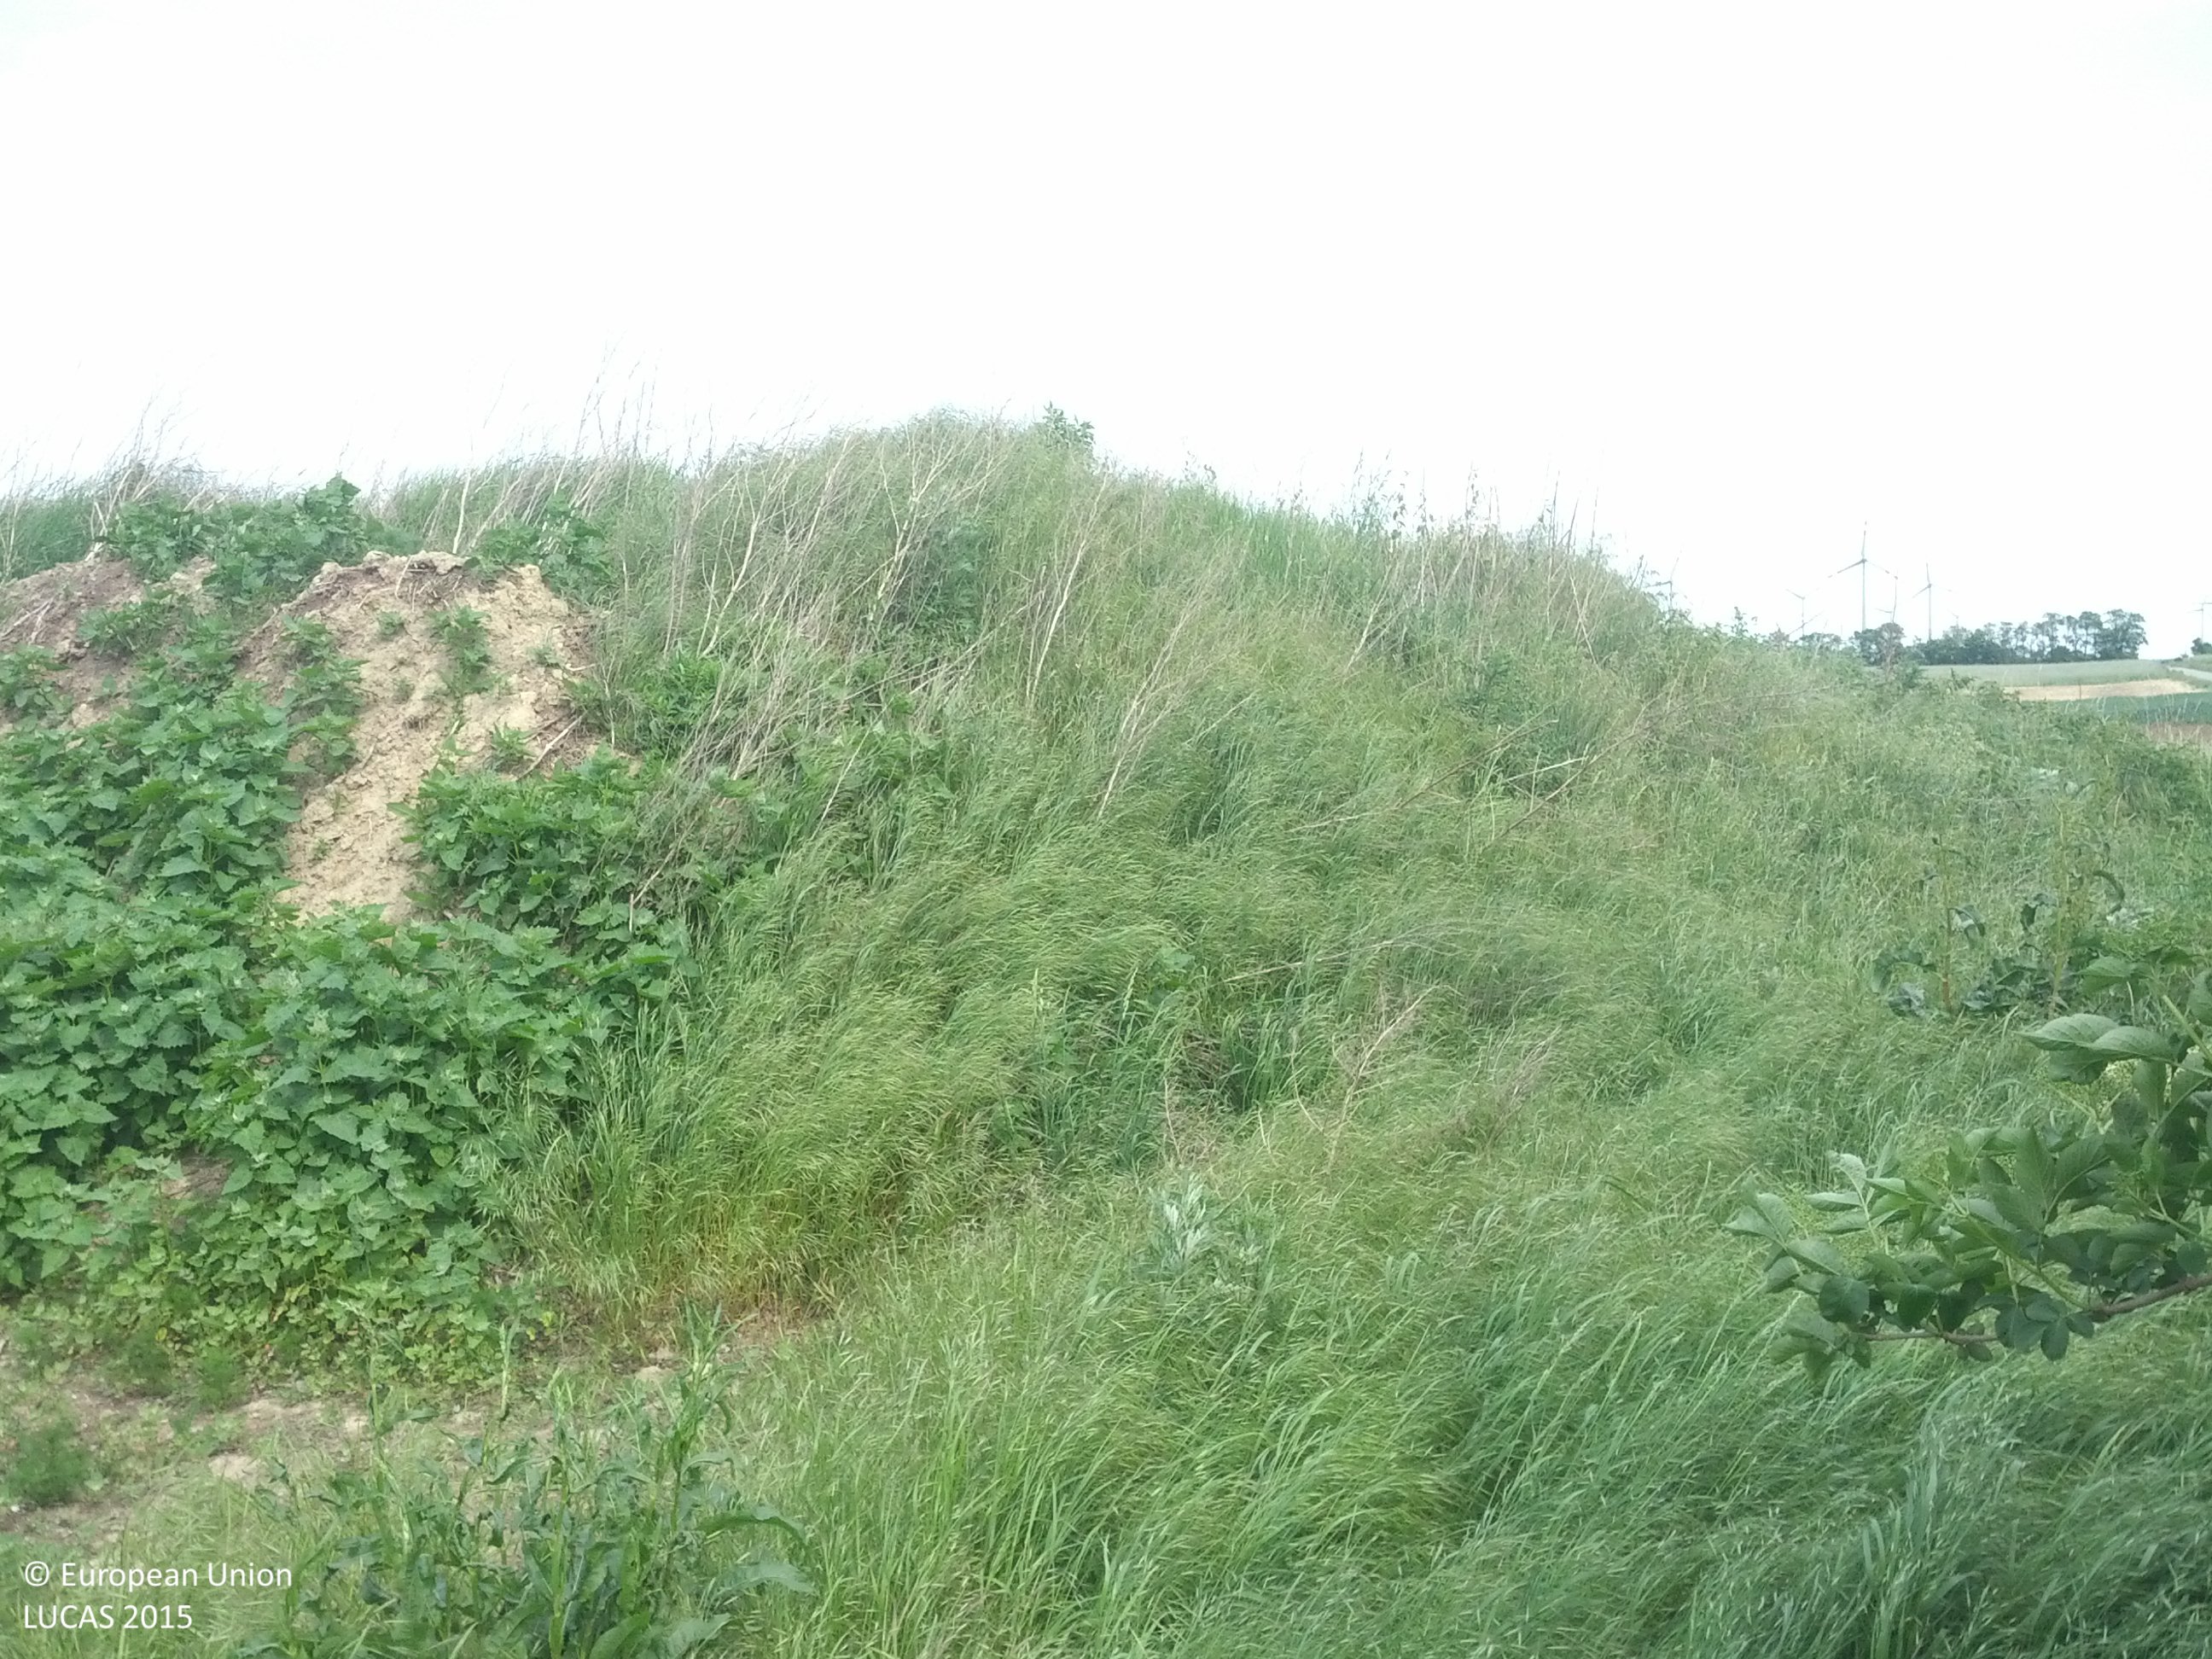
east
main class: Grassland
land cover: Spontaneously vegetated surfaces
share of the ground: > 75 %
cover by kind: herbaceous plants 65 %, unconsolidated bare surface 30 %, shrubs 5 %
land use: Energy production
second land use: Waste treatment
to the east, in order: Spontaneously vegetated surfaces; Fences; Grass margins; Maize; Barley; Common wheat; Other bare soil
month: May
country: AT
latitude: 48.0587
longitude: 16.9440
